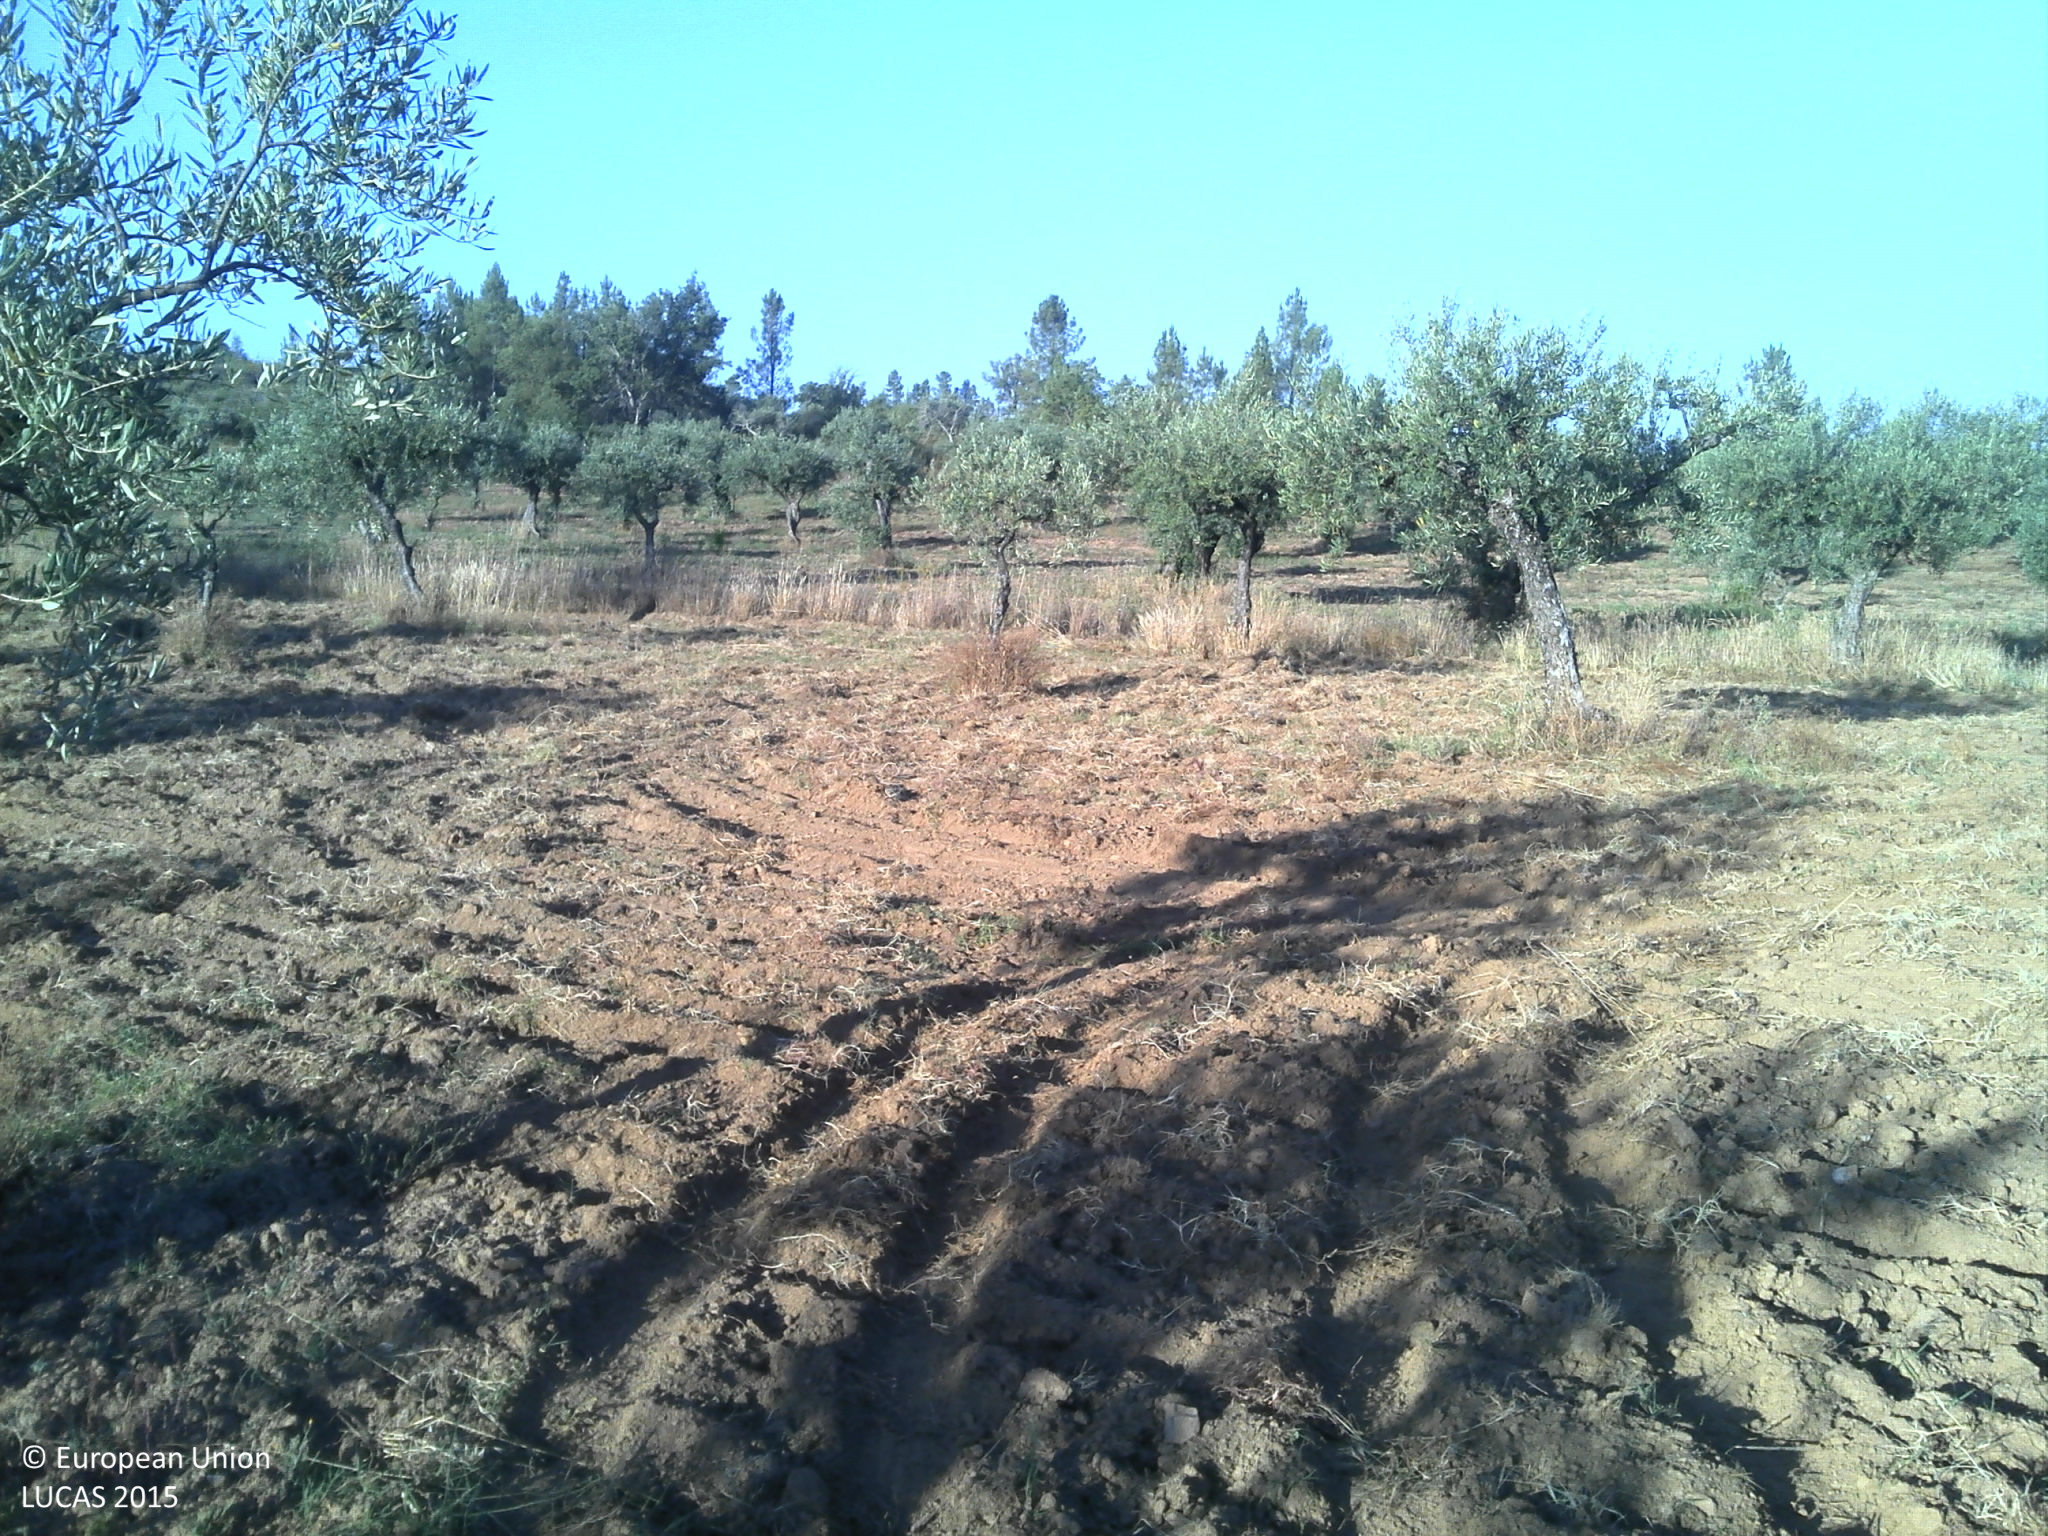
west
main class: Cropland
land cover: Olive groves
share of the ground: 25 - 50 %
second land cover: Other bare soil
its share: > 75 %
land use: Agriculture (excluding fallow land and kitchen gardens)
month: June
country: PT
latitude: 39.9229
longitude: -7.5710
